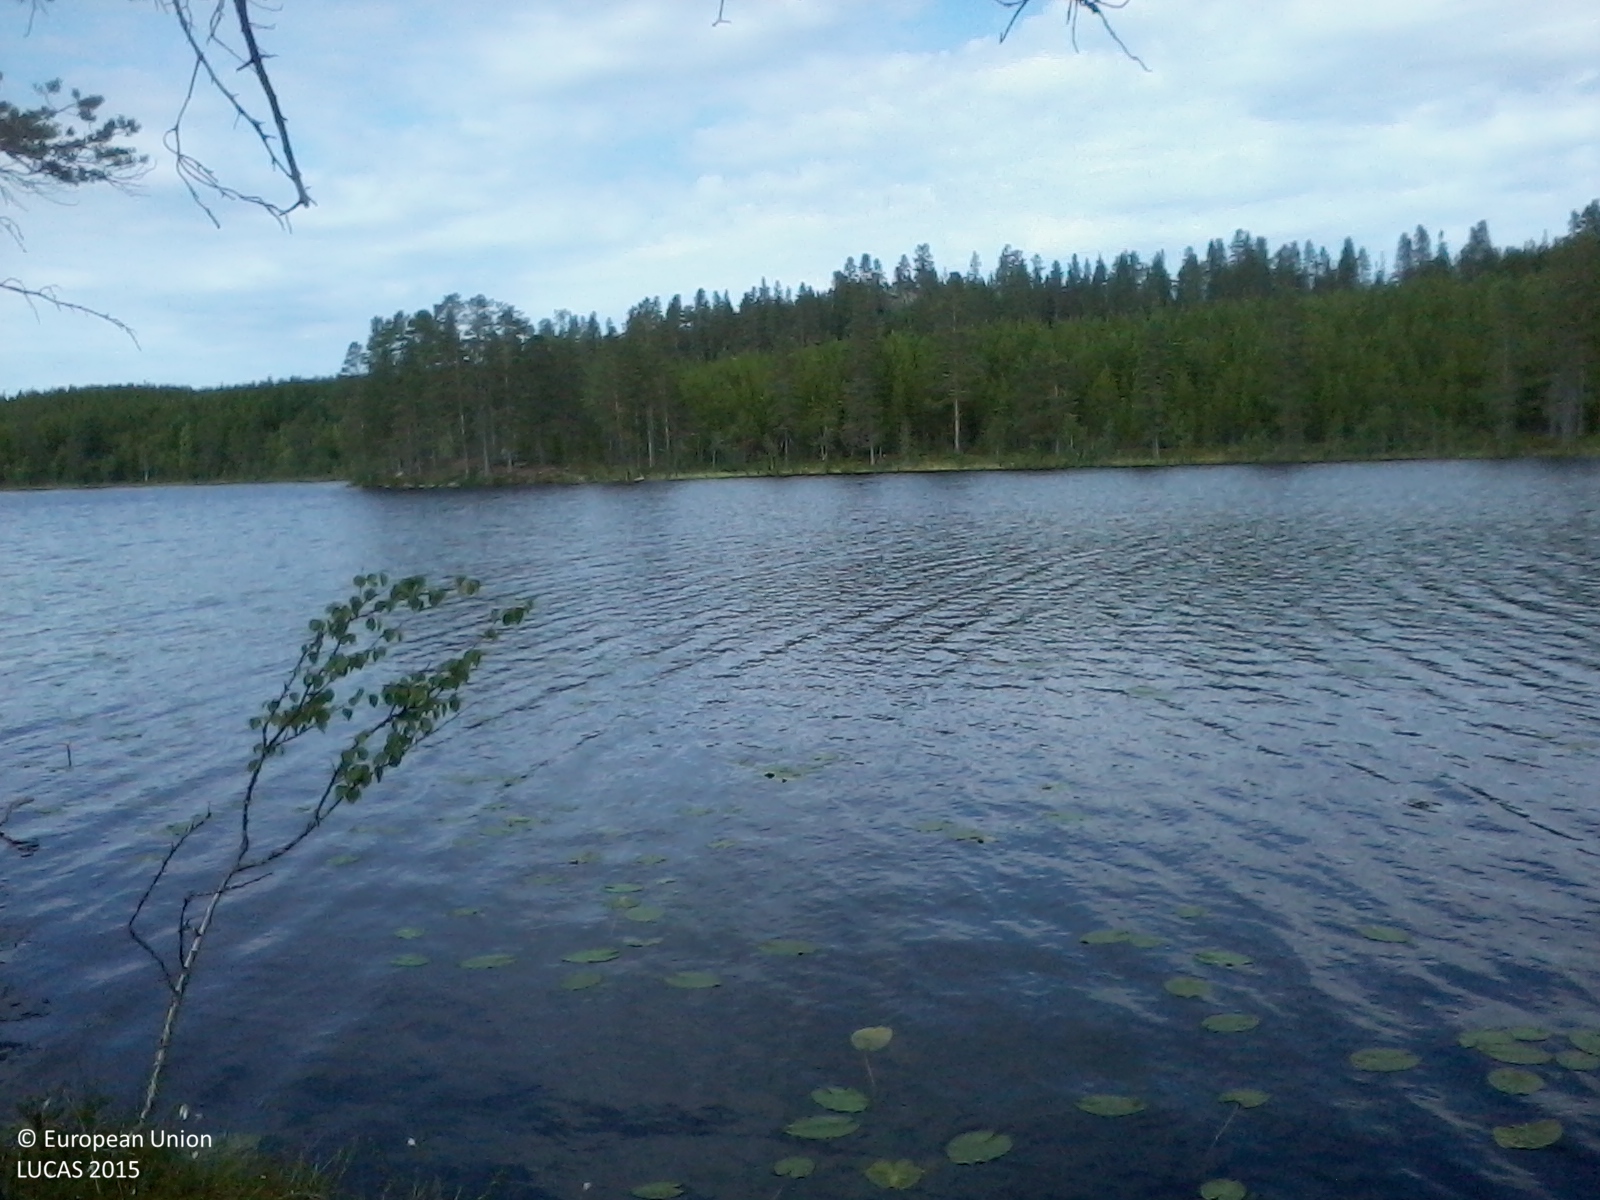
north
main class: Woodland
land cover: Pine dominated coniferous woodland
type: boreal forest
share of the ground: 10 - 25 %
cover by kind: shrubs 60 %, coniferous forest trees 20 %, herbaceous plants 15 %, lichens and mosses 5 %
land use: Forestry
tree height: > 5 m
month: August
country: SE
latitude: 62.8789
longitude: 17.1148
